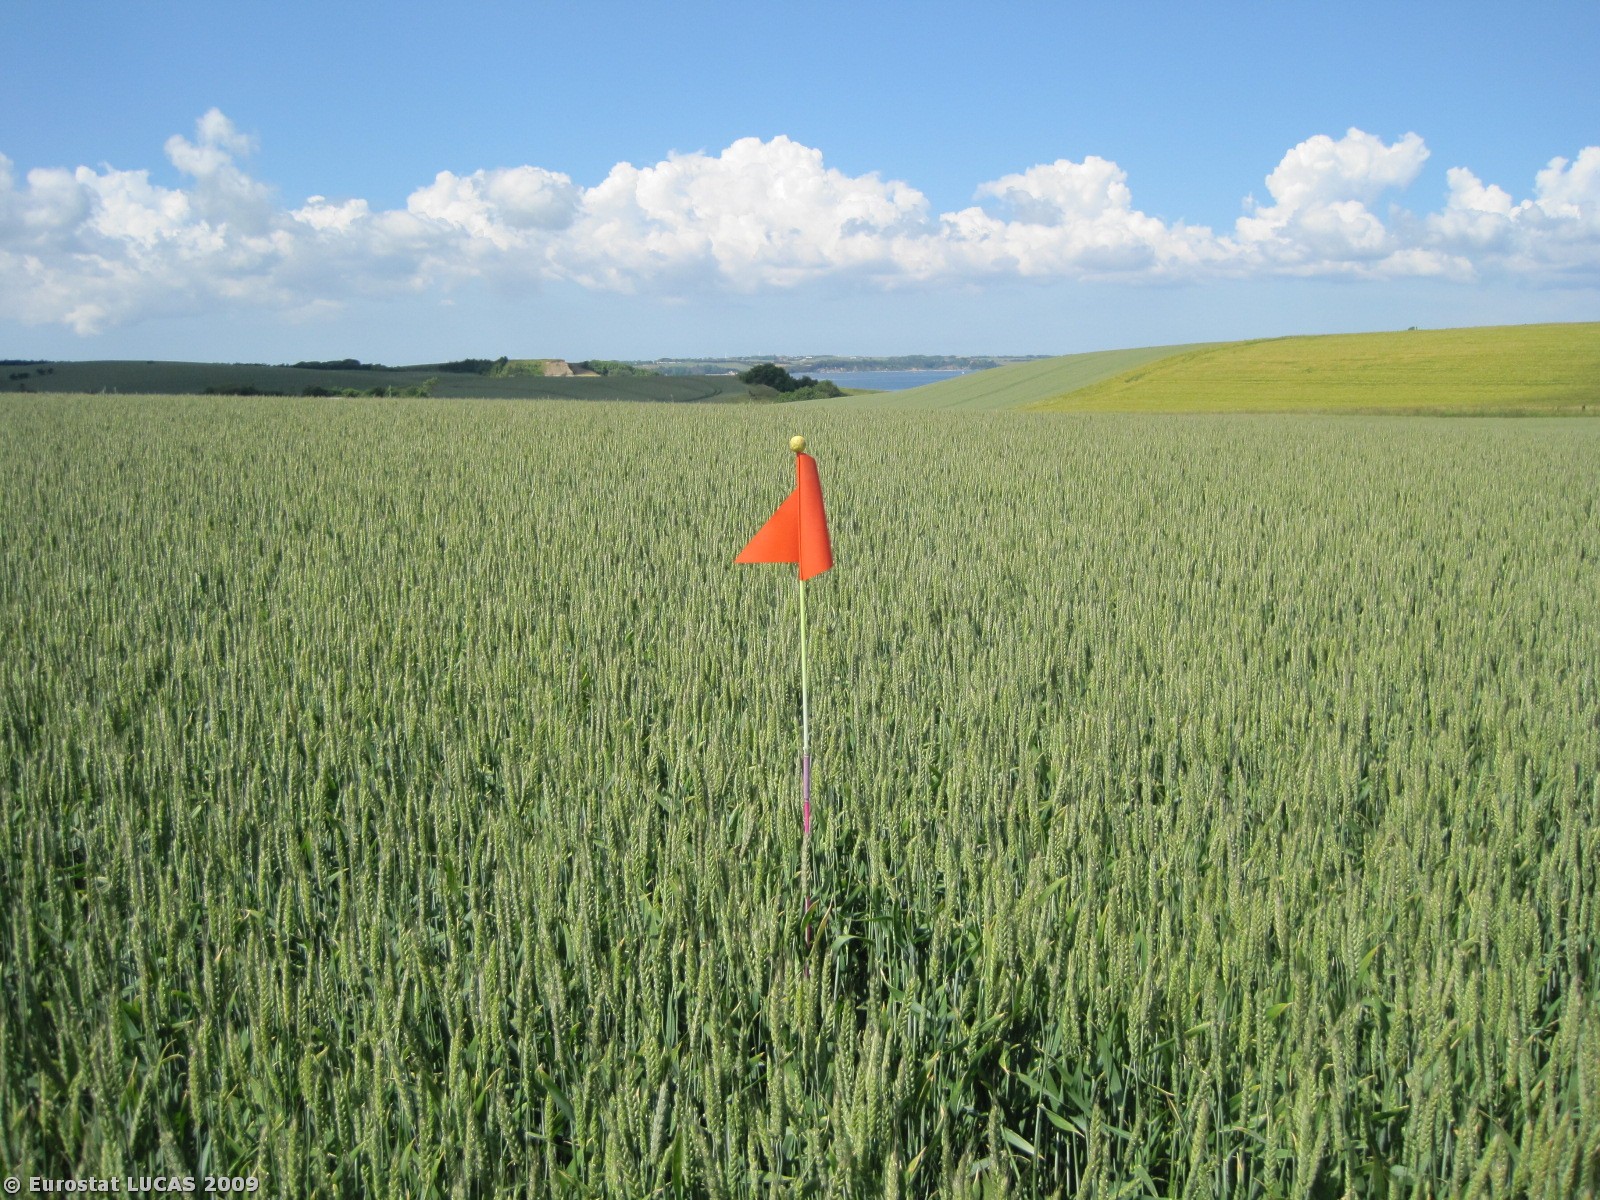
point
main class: Cropland
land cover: Common wheat
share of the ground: > 75 %
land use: Agriculture (excluding fallow land and kitchen gardens)
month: June
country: DK
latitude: 56.8824
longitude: 8.7054
